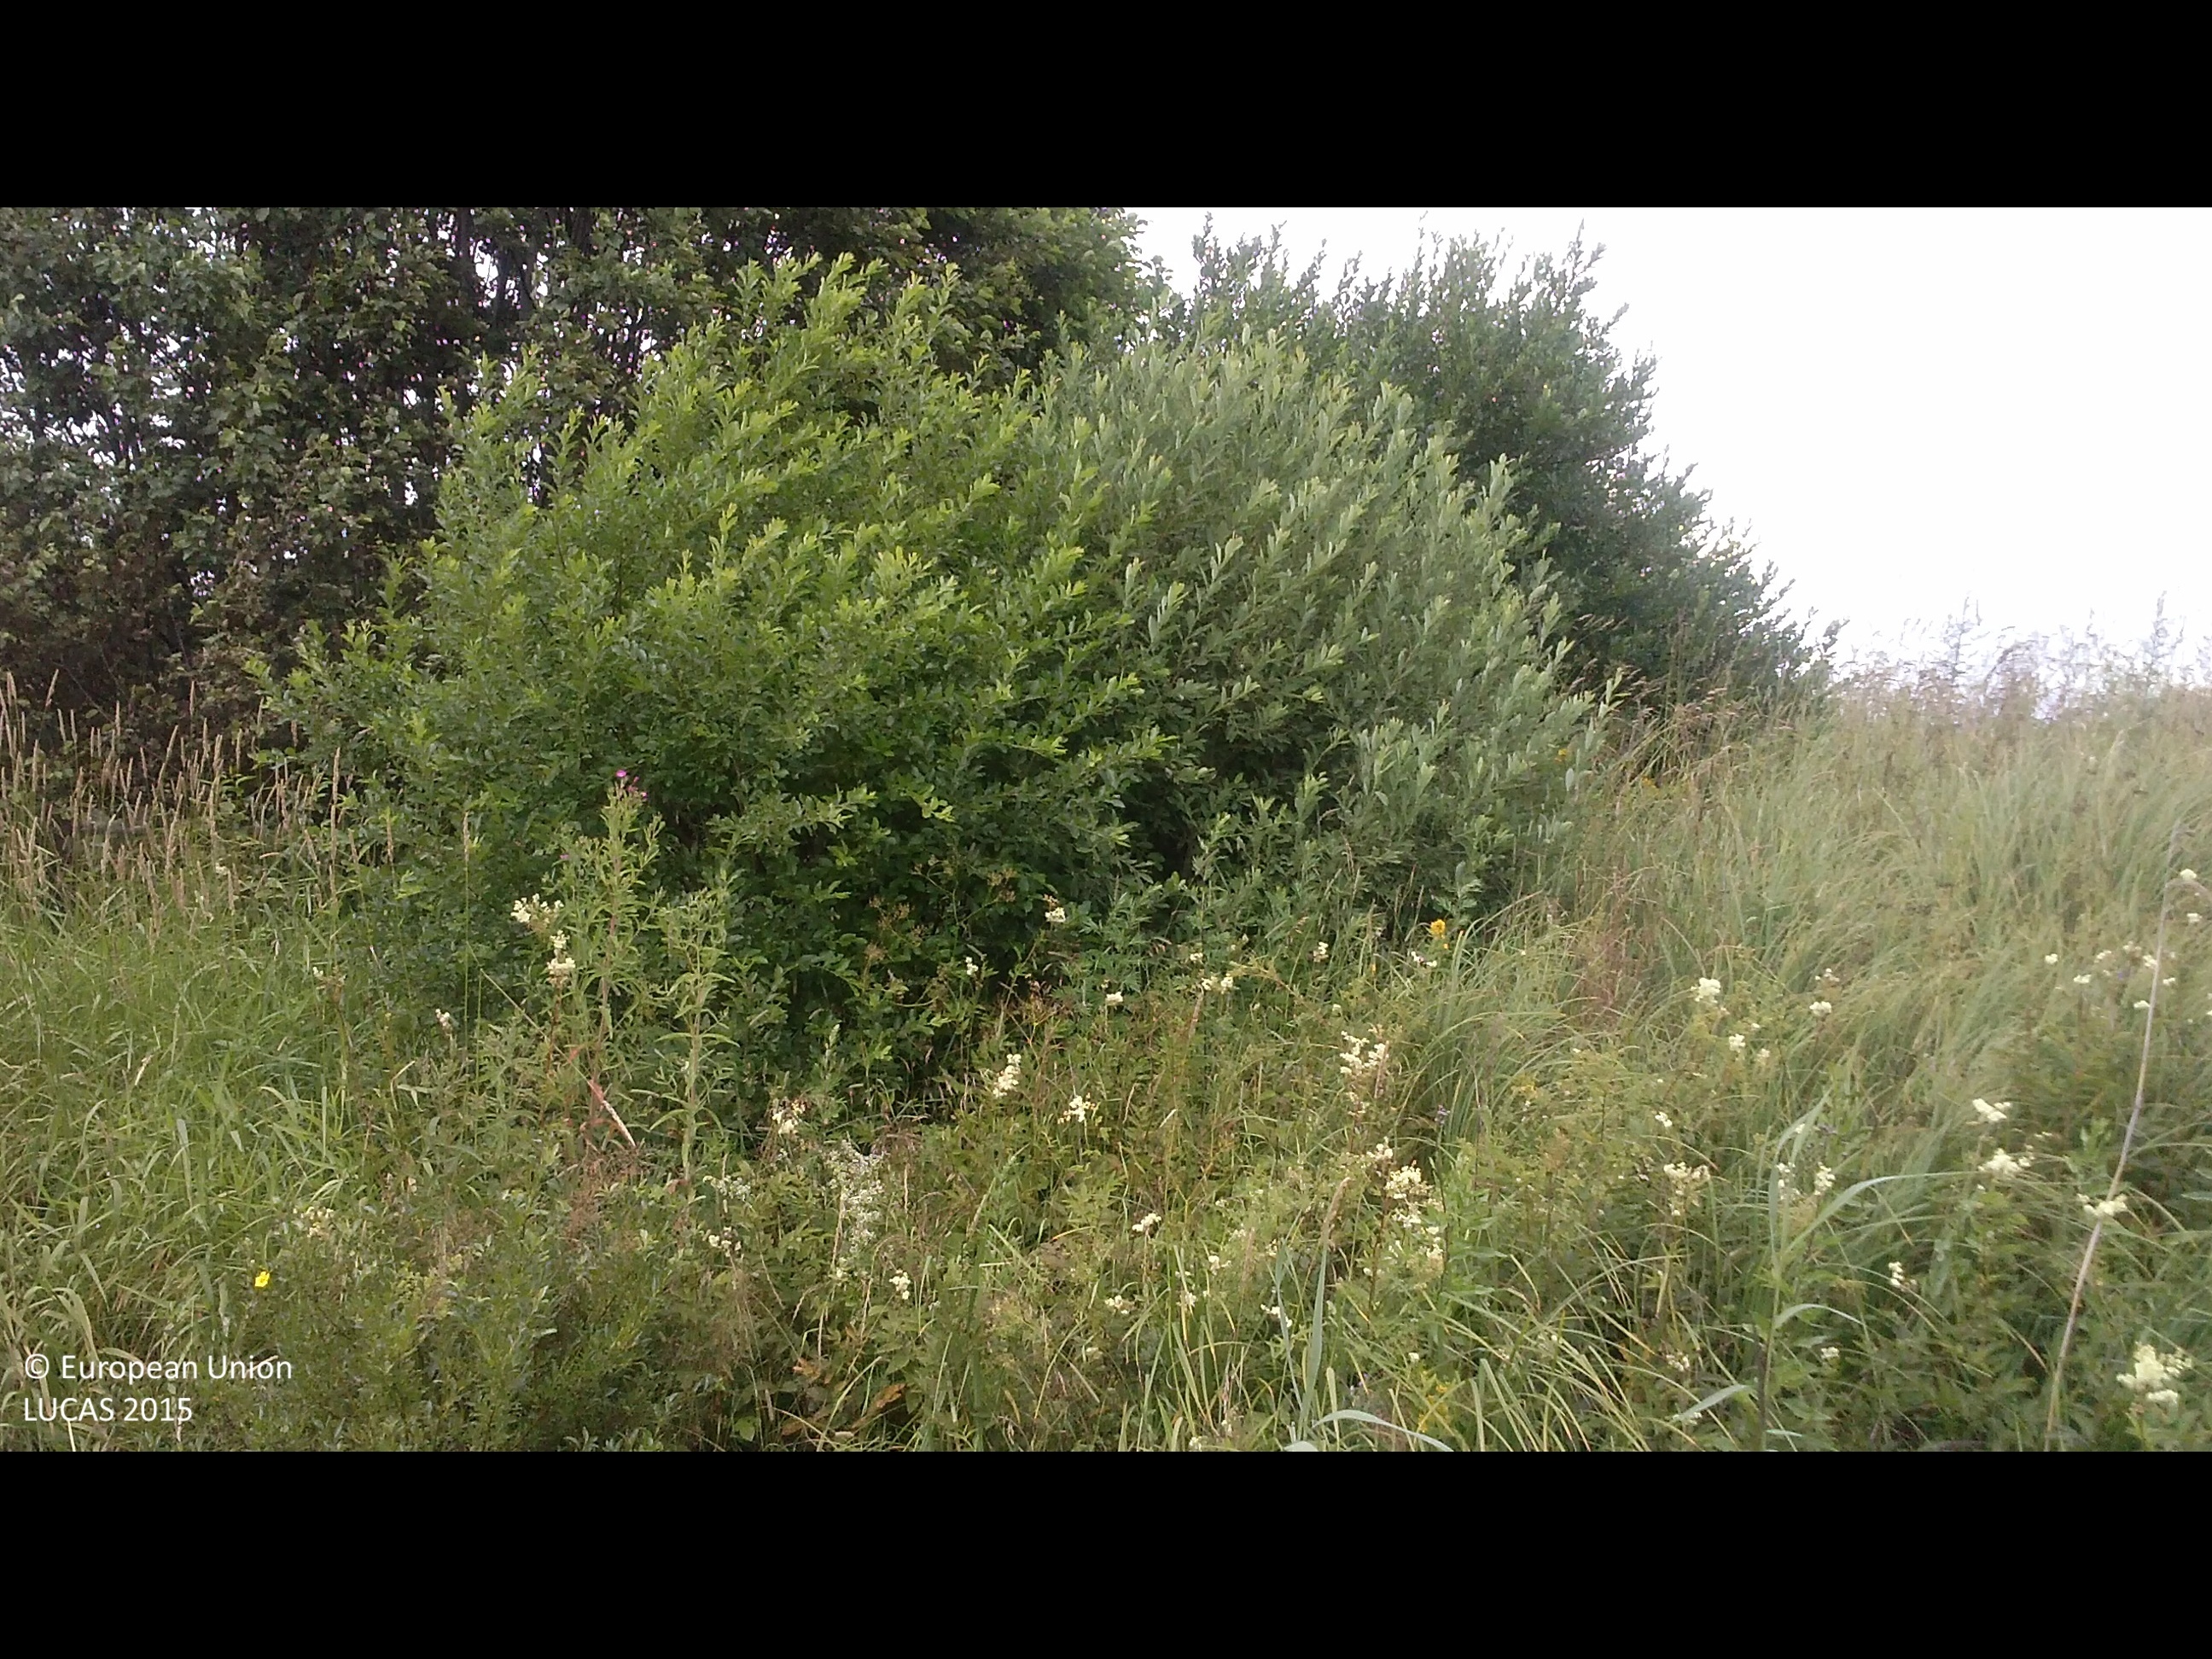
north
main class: Grassland
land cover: Spontaneously vegetated surfaces
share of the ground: > 75 %
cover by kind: herbaceous plants 100 %
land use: Semi-natural and natural areas not in use
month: July
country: LV
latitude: 56.4434
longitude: 26.9842
